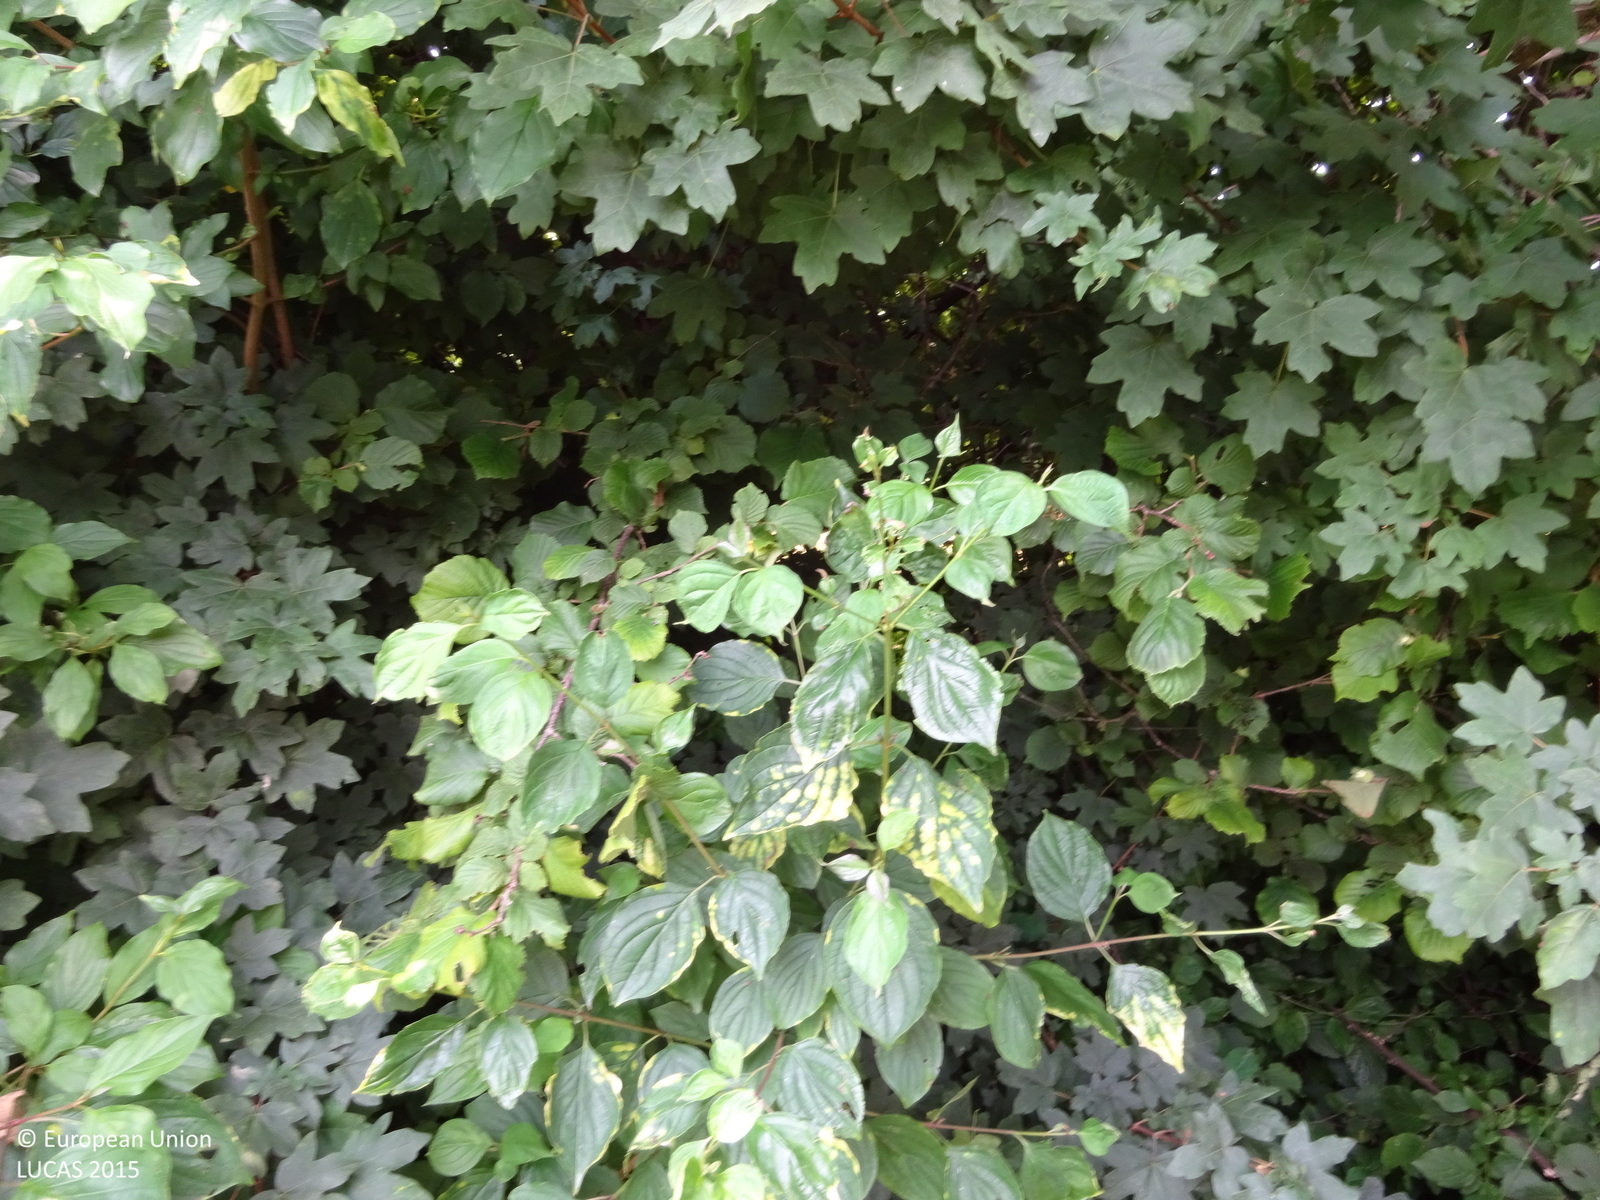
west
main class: Cropland
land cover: Maize
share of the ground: > 75 %
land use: Agriculture (excluding fallow land and kitchen gardens)
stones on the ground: < 10 %
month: July
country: AT
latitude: 46.9423
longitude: 15.9782
